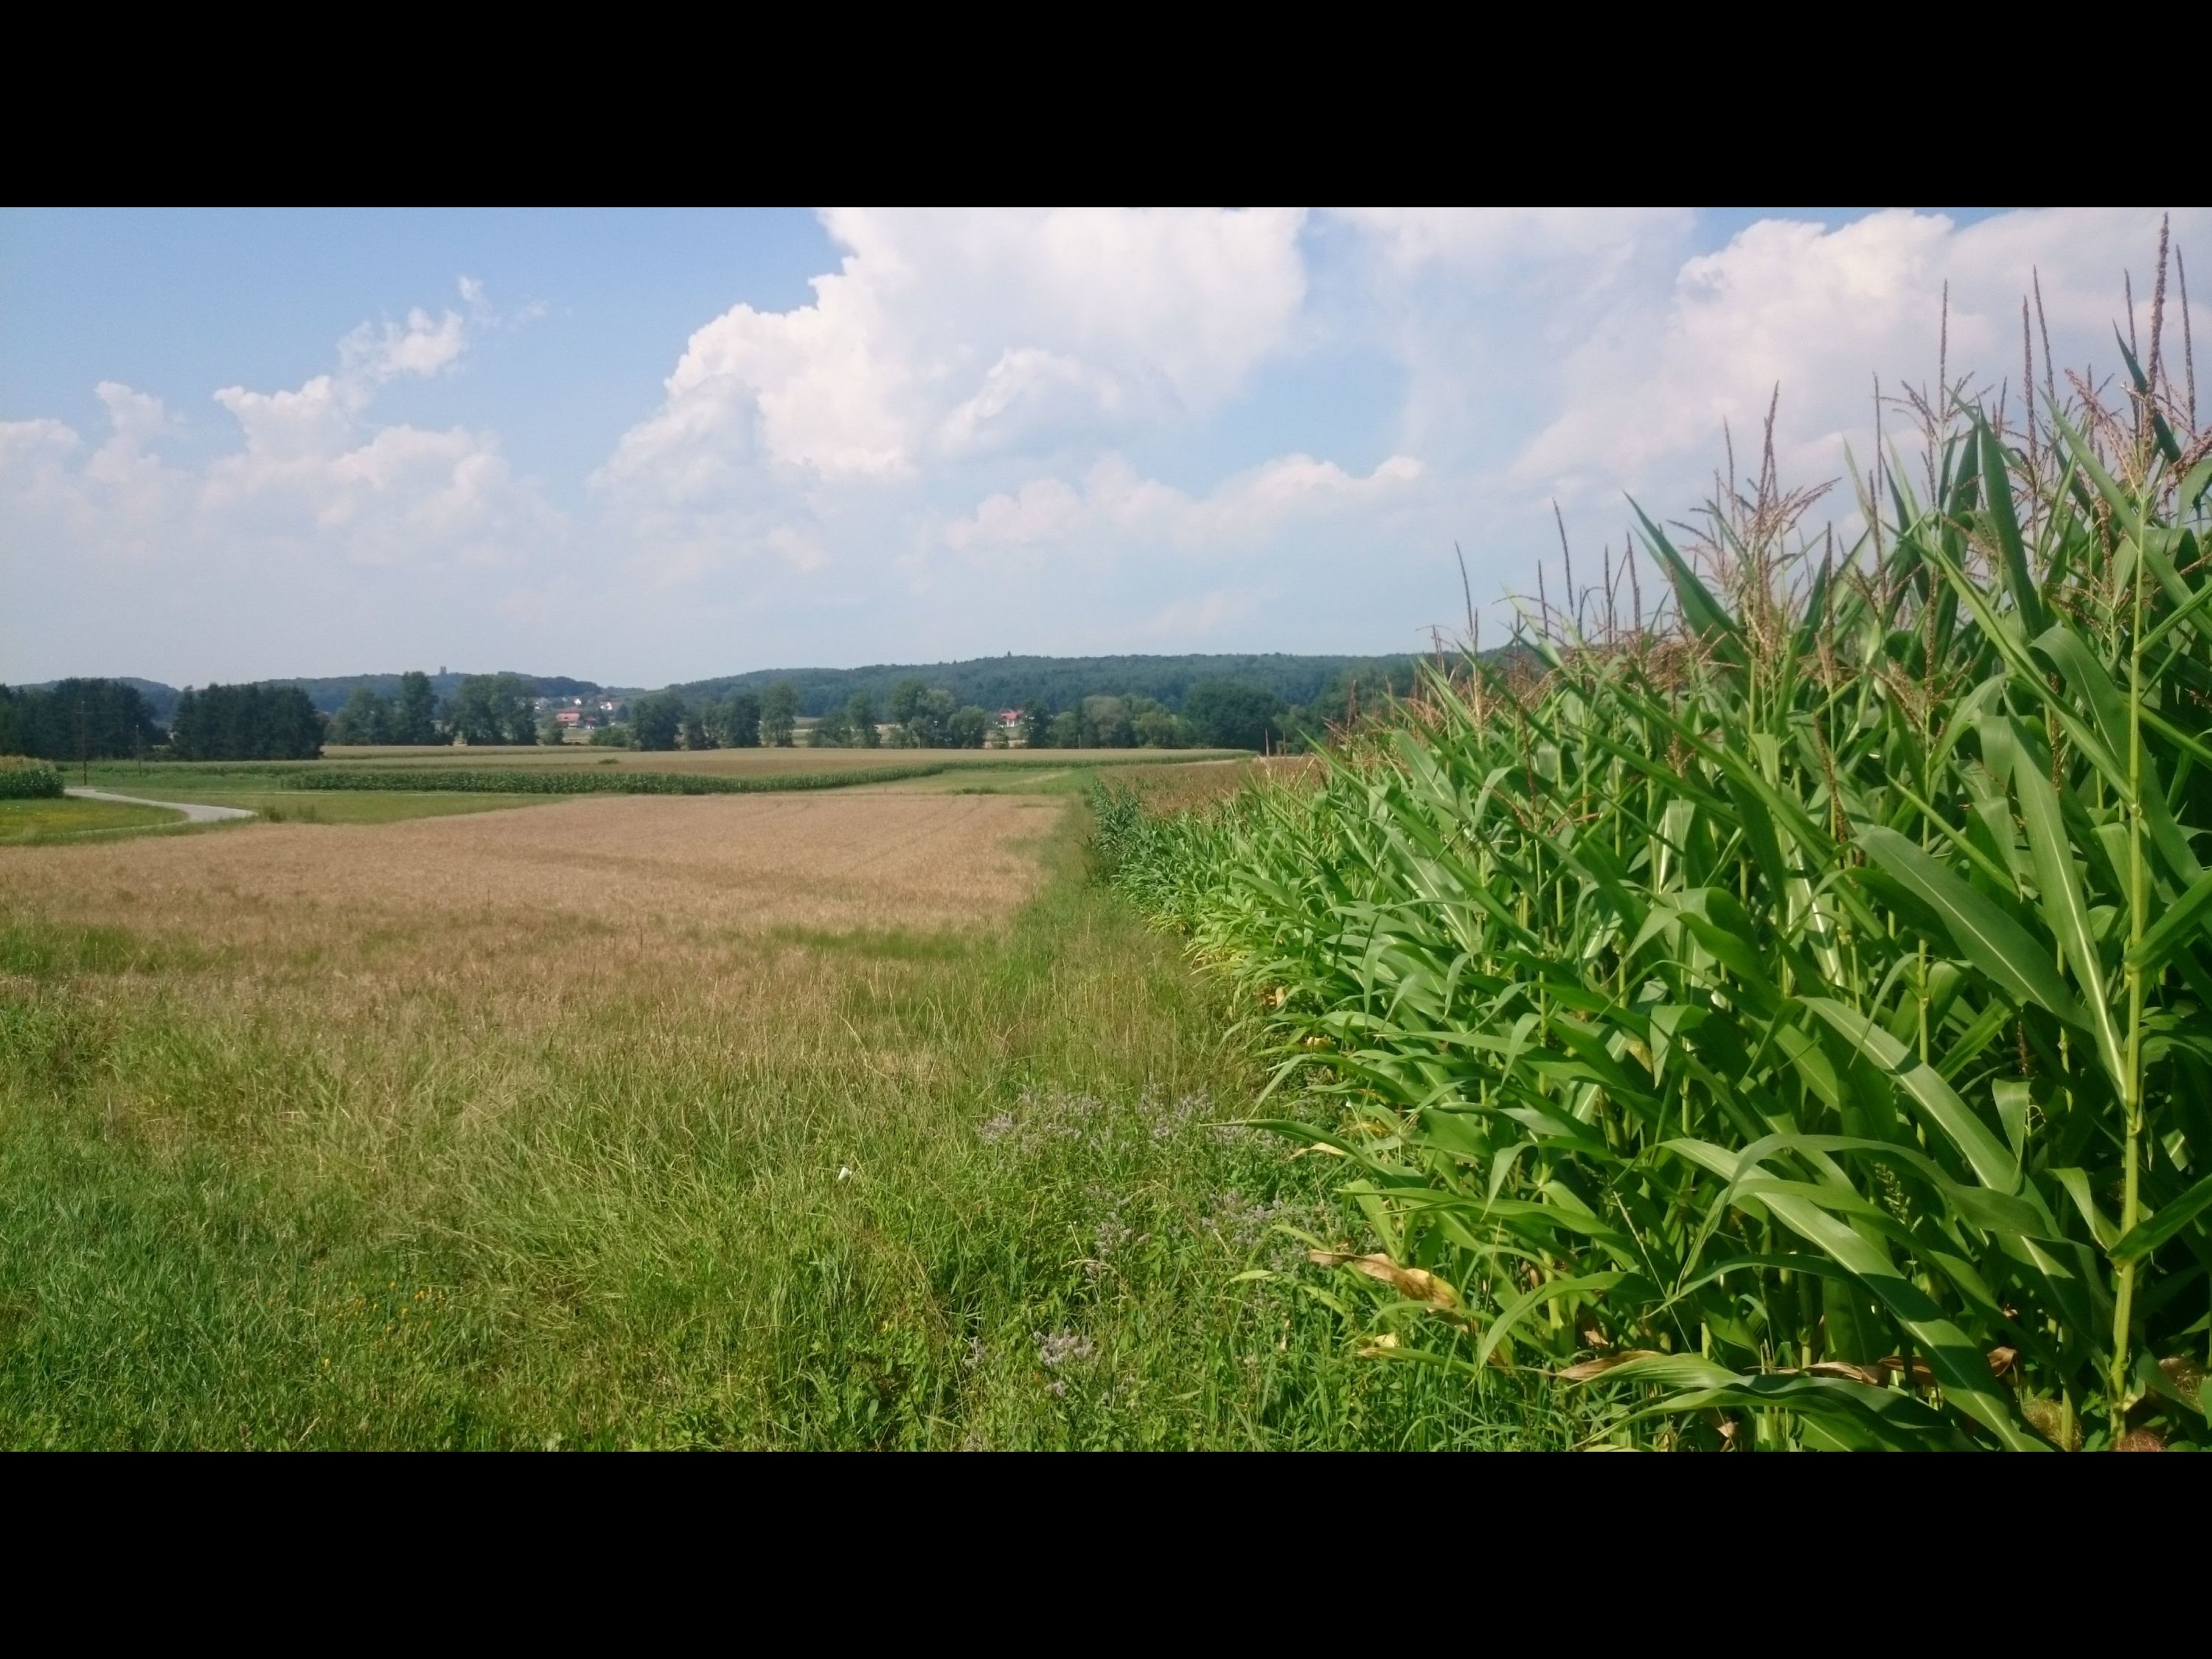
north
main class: Cropland
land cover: Maize
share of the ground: > 75 %
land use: Agriculture (excluding fallow land and kitchen gardens)
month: July
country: AT
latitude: 47.0320
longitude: 15.9884
